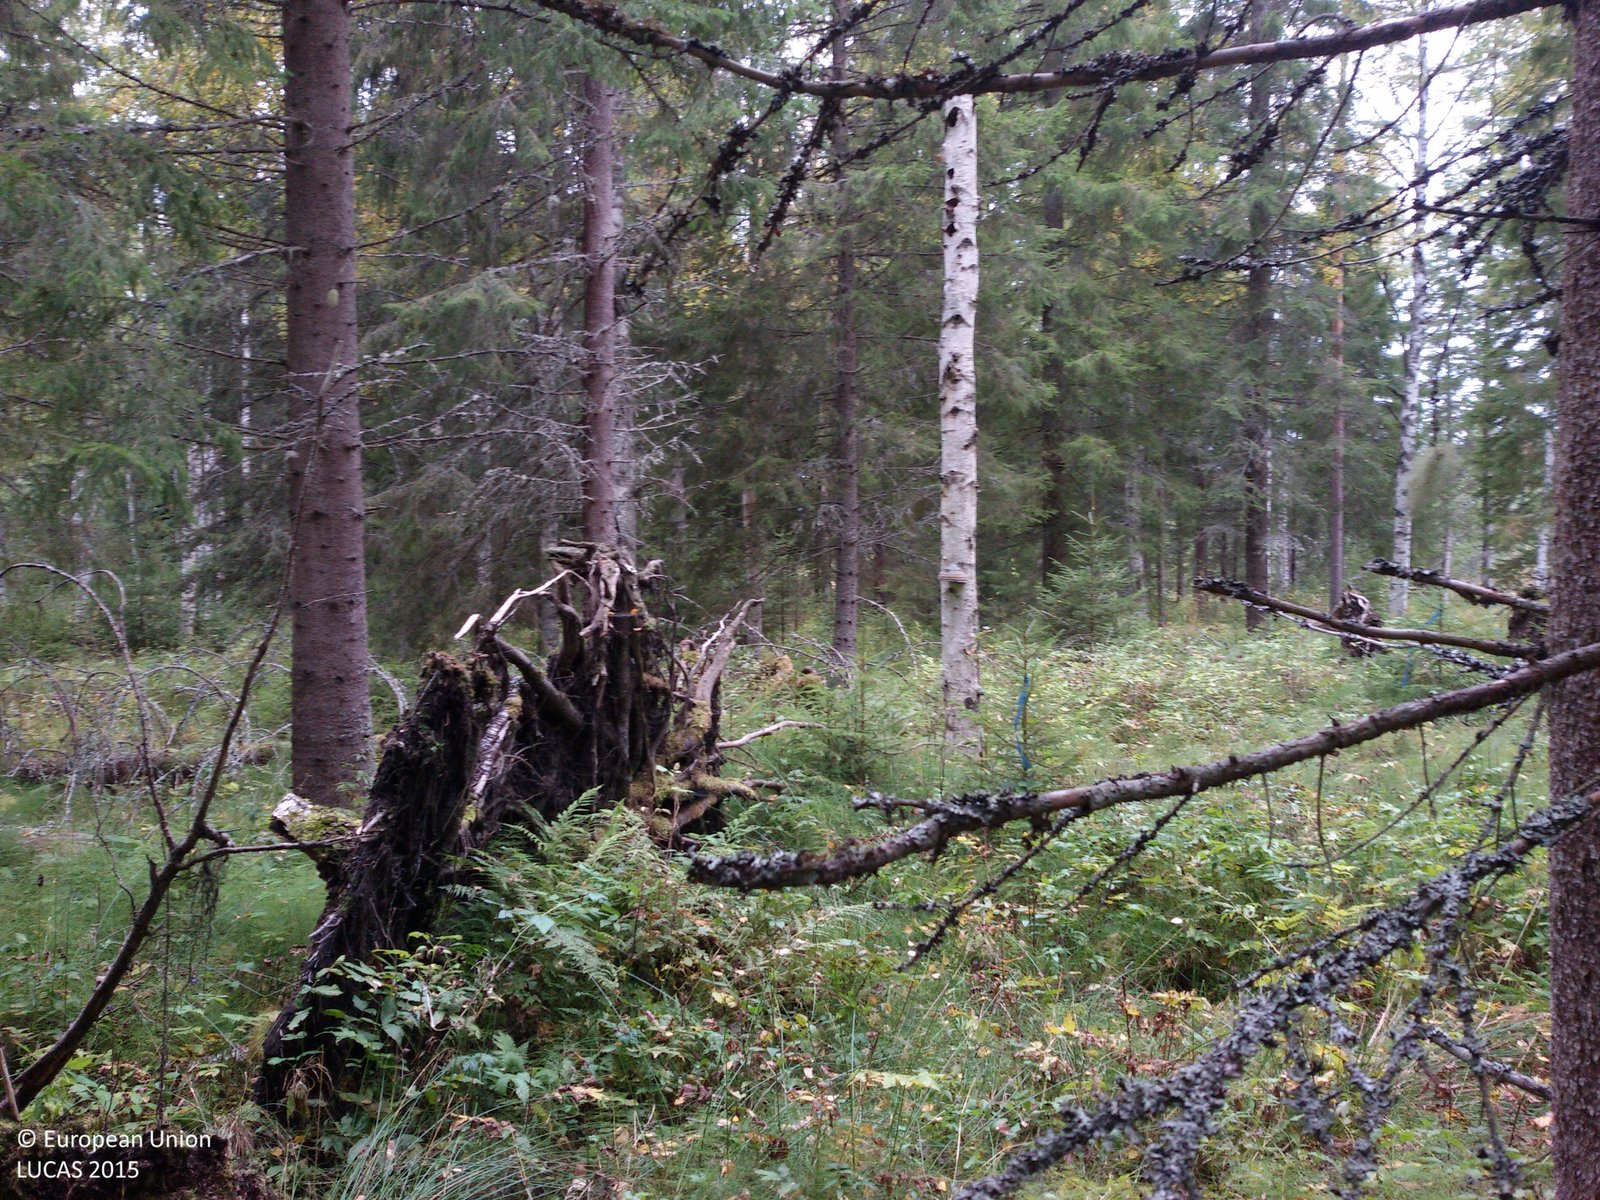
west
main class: Woodland
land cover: Spruce dominated mixed woodland
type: boreal forest
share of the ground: 50 - 75 %
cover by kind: coniferous forest trees 40 %, broadleaved forest trees 30 %, herbaceous plants 15 %, lichens and mosses 10 %, shrubs 5 %
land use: Forestry
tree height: > 5 m
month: September
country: SE
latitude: 60.7660
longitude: 14.8147
